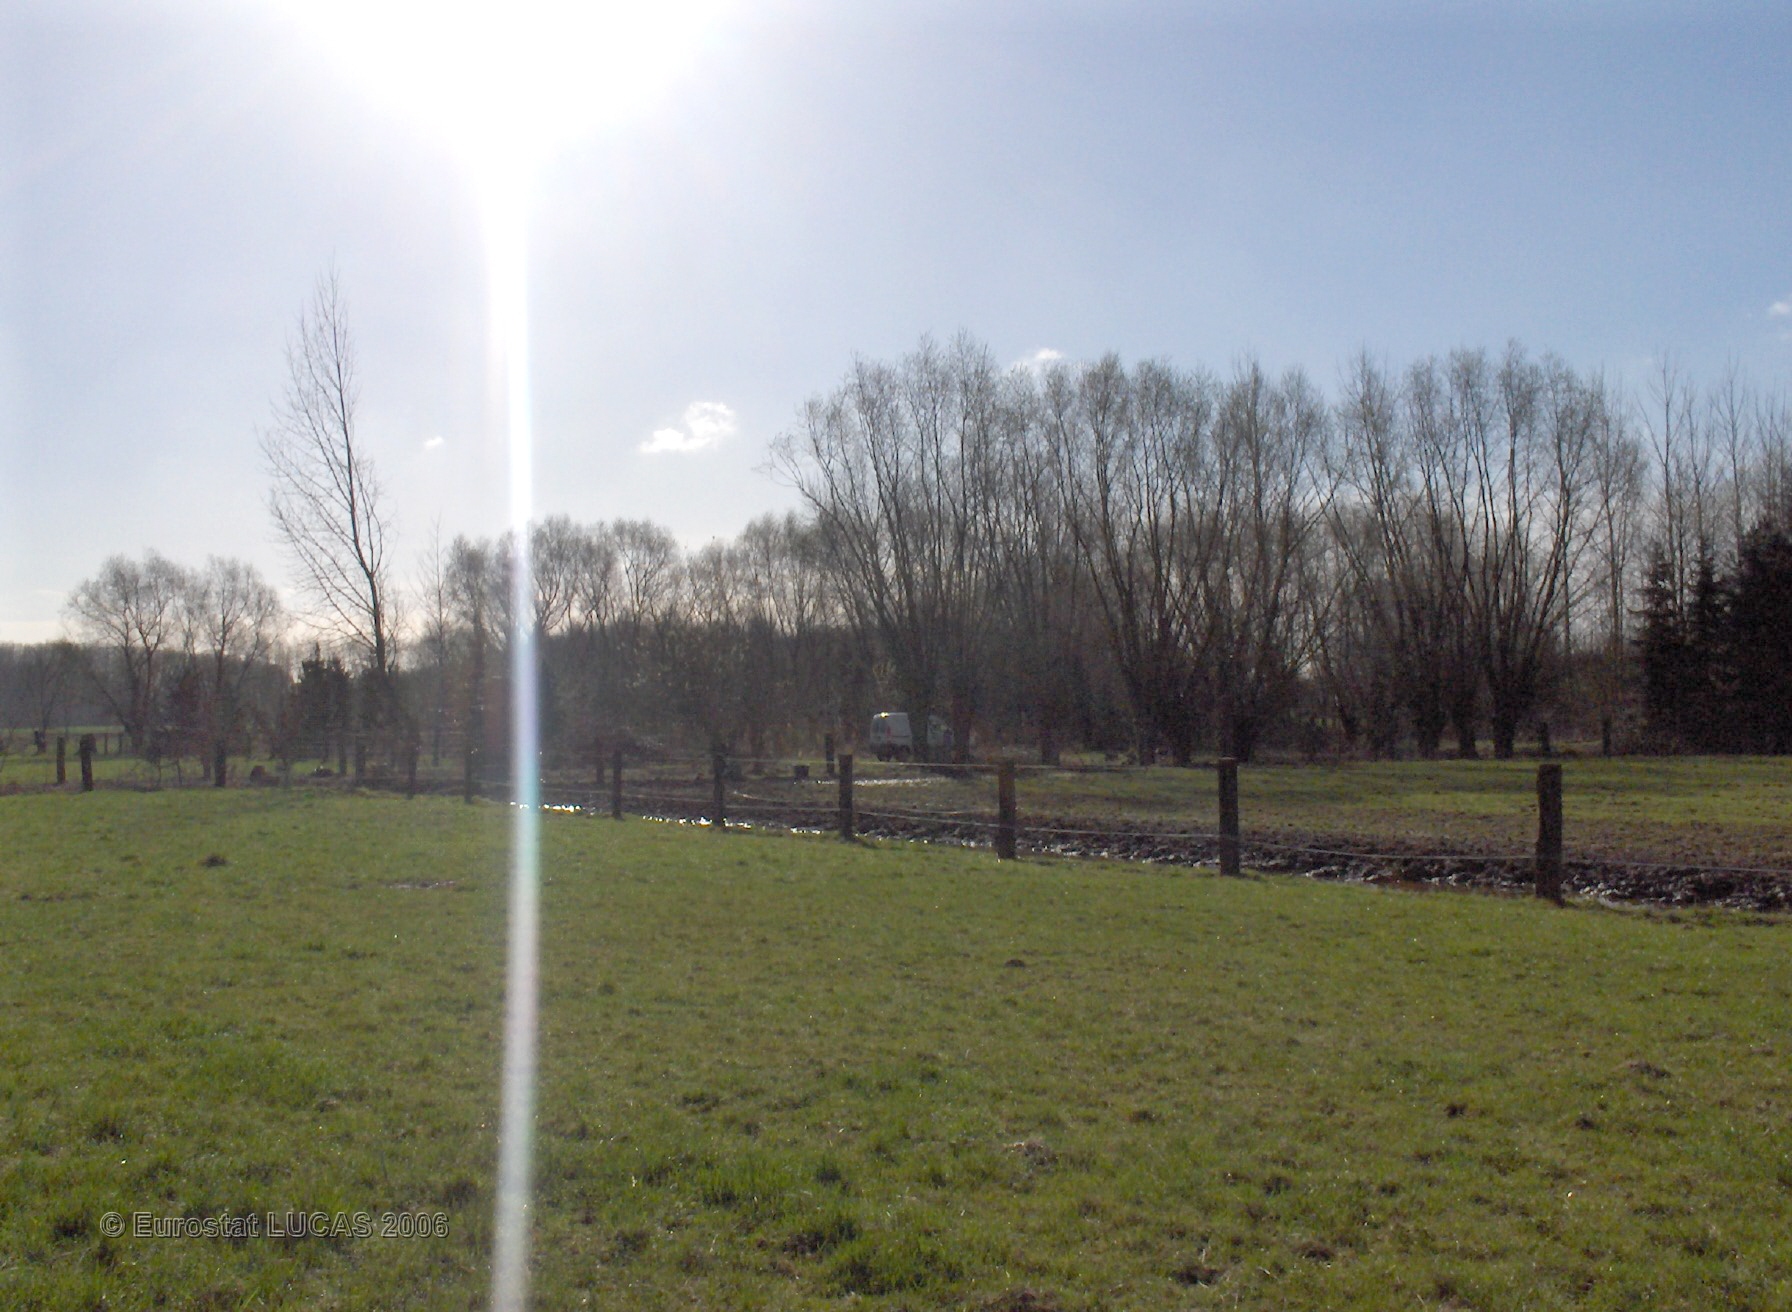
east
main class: Grassland
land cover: Grassland without tree/shrub cover
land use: Agriculture (excluding fallow land and kitchen gardens)
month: April
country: BE
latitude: 50.9851
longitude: 4.4257
